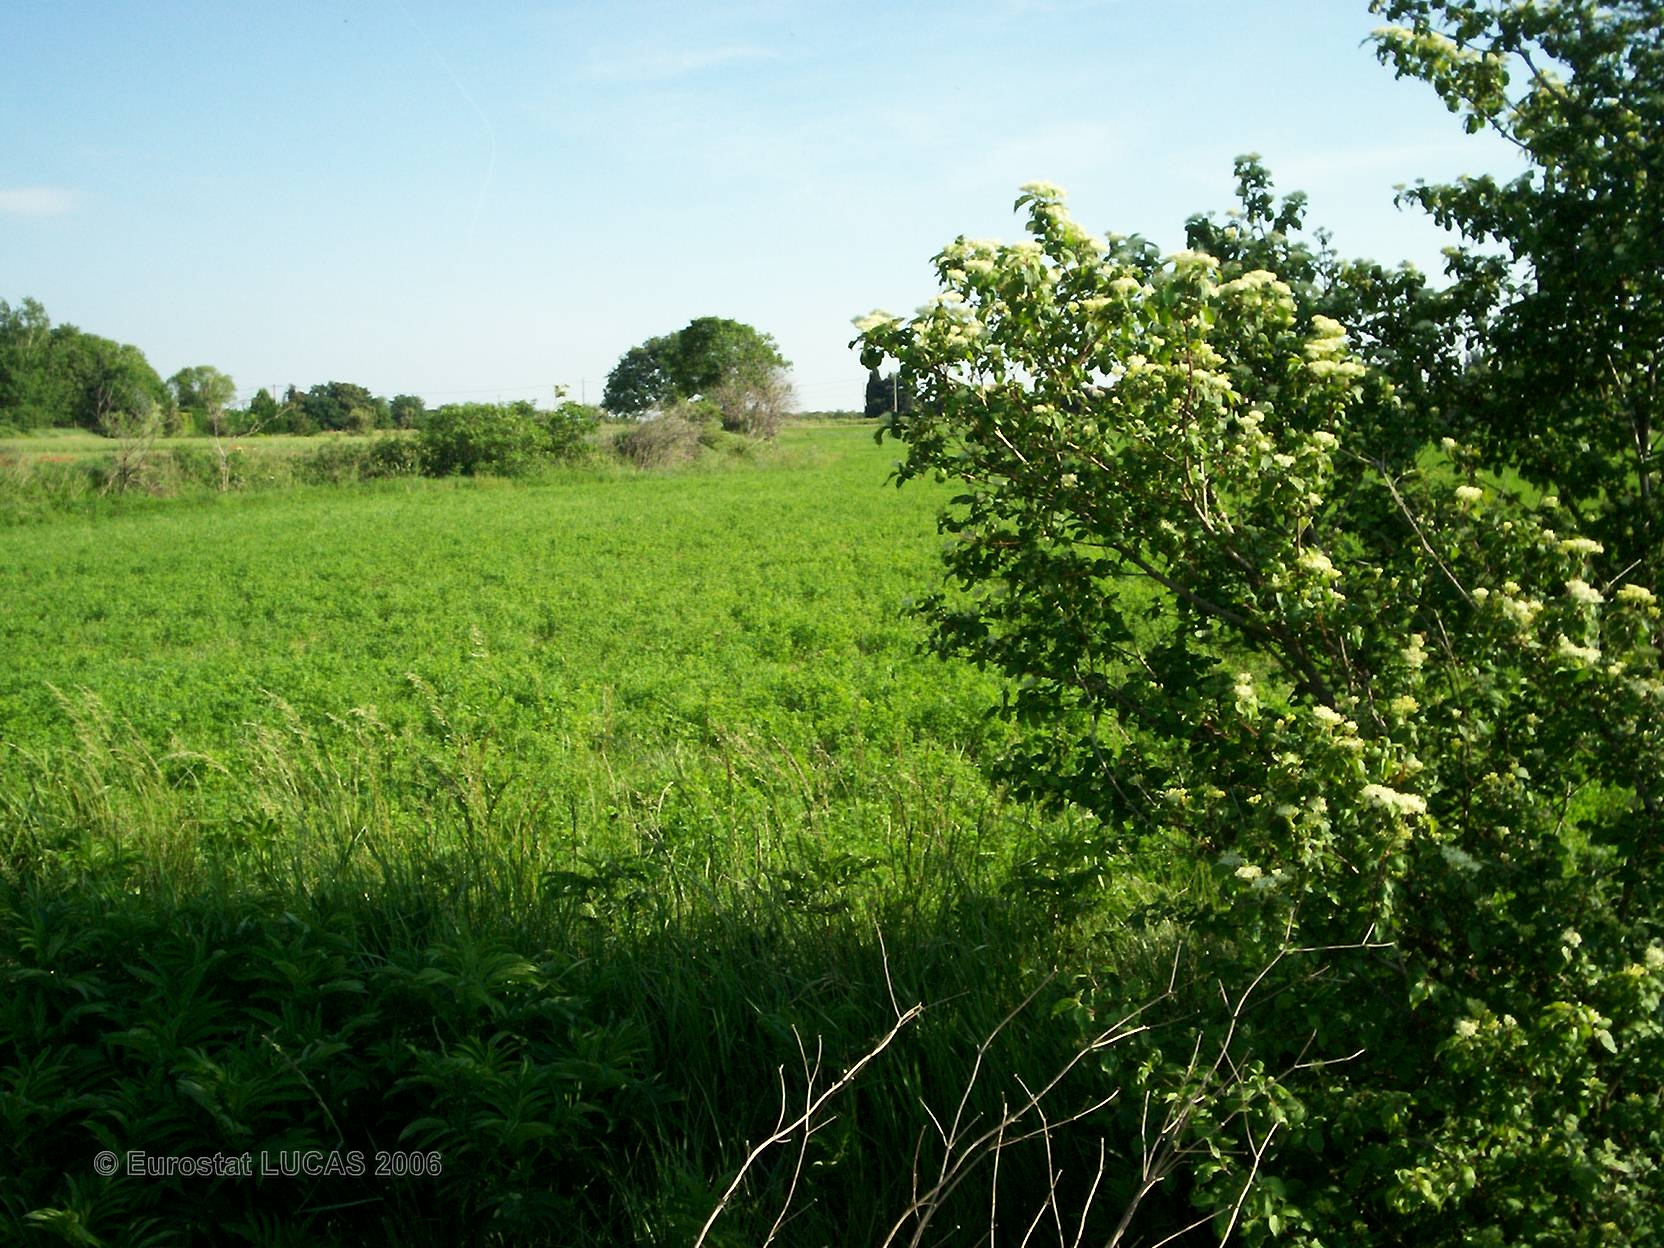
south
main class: Cropland
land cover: Barley
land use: Agriculture (excluding fallow land and kitchen gardens)
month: May
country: FR
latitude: 44.3313
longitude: 4.8531
